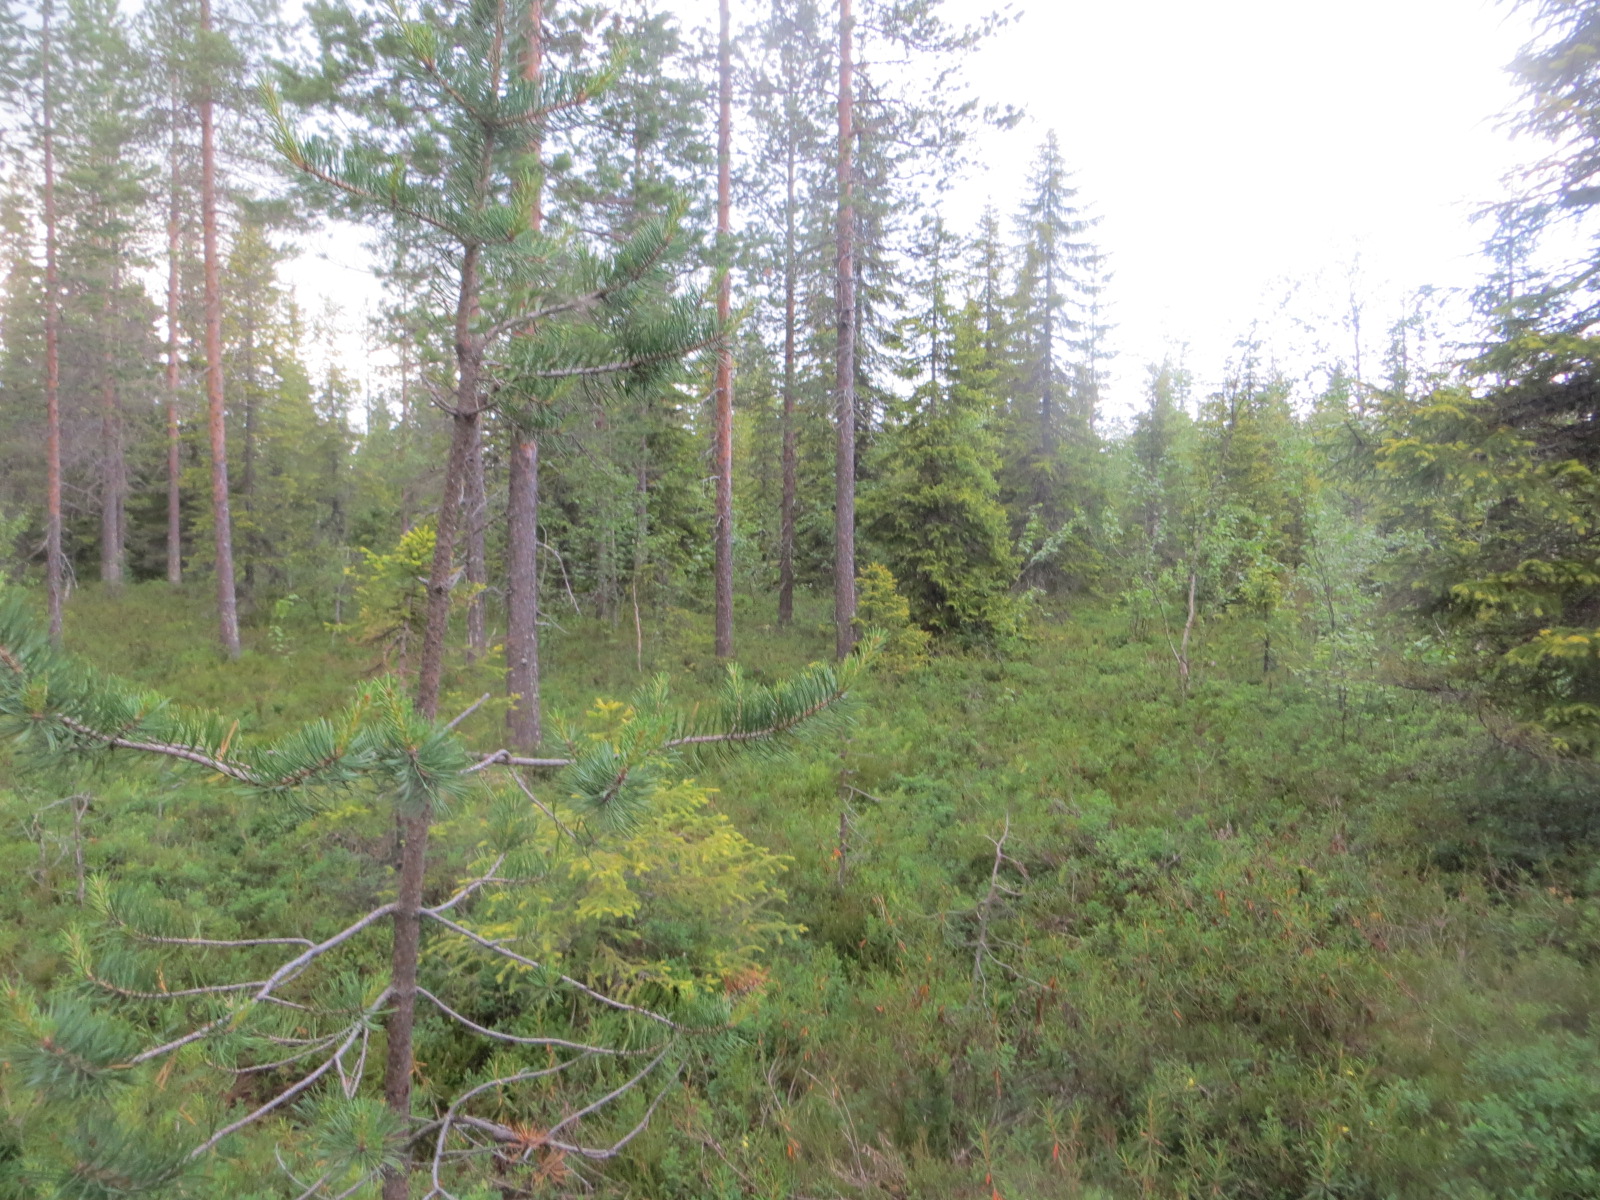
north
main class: Woodland
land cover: Pine dominated mixed woodland
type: boreal forest
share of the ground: 50 - 75 %
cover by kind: shrubs 50 %, coniferous forest trees 25 %, broadleaved forest trees 25 %
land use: Forestry
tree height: > 5 m
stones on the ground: < 10 %
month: July
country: FI
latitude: 66.2737
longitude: 24.5023
